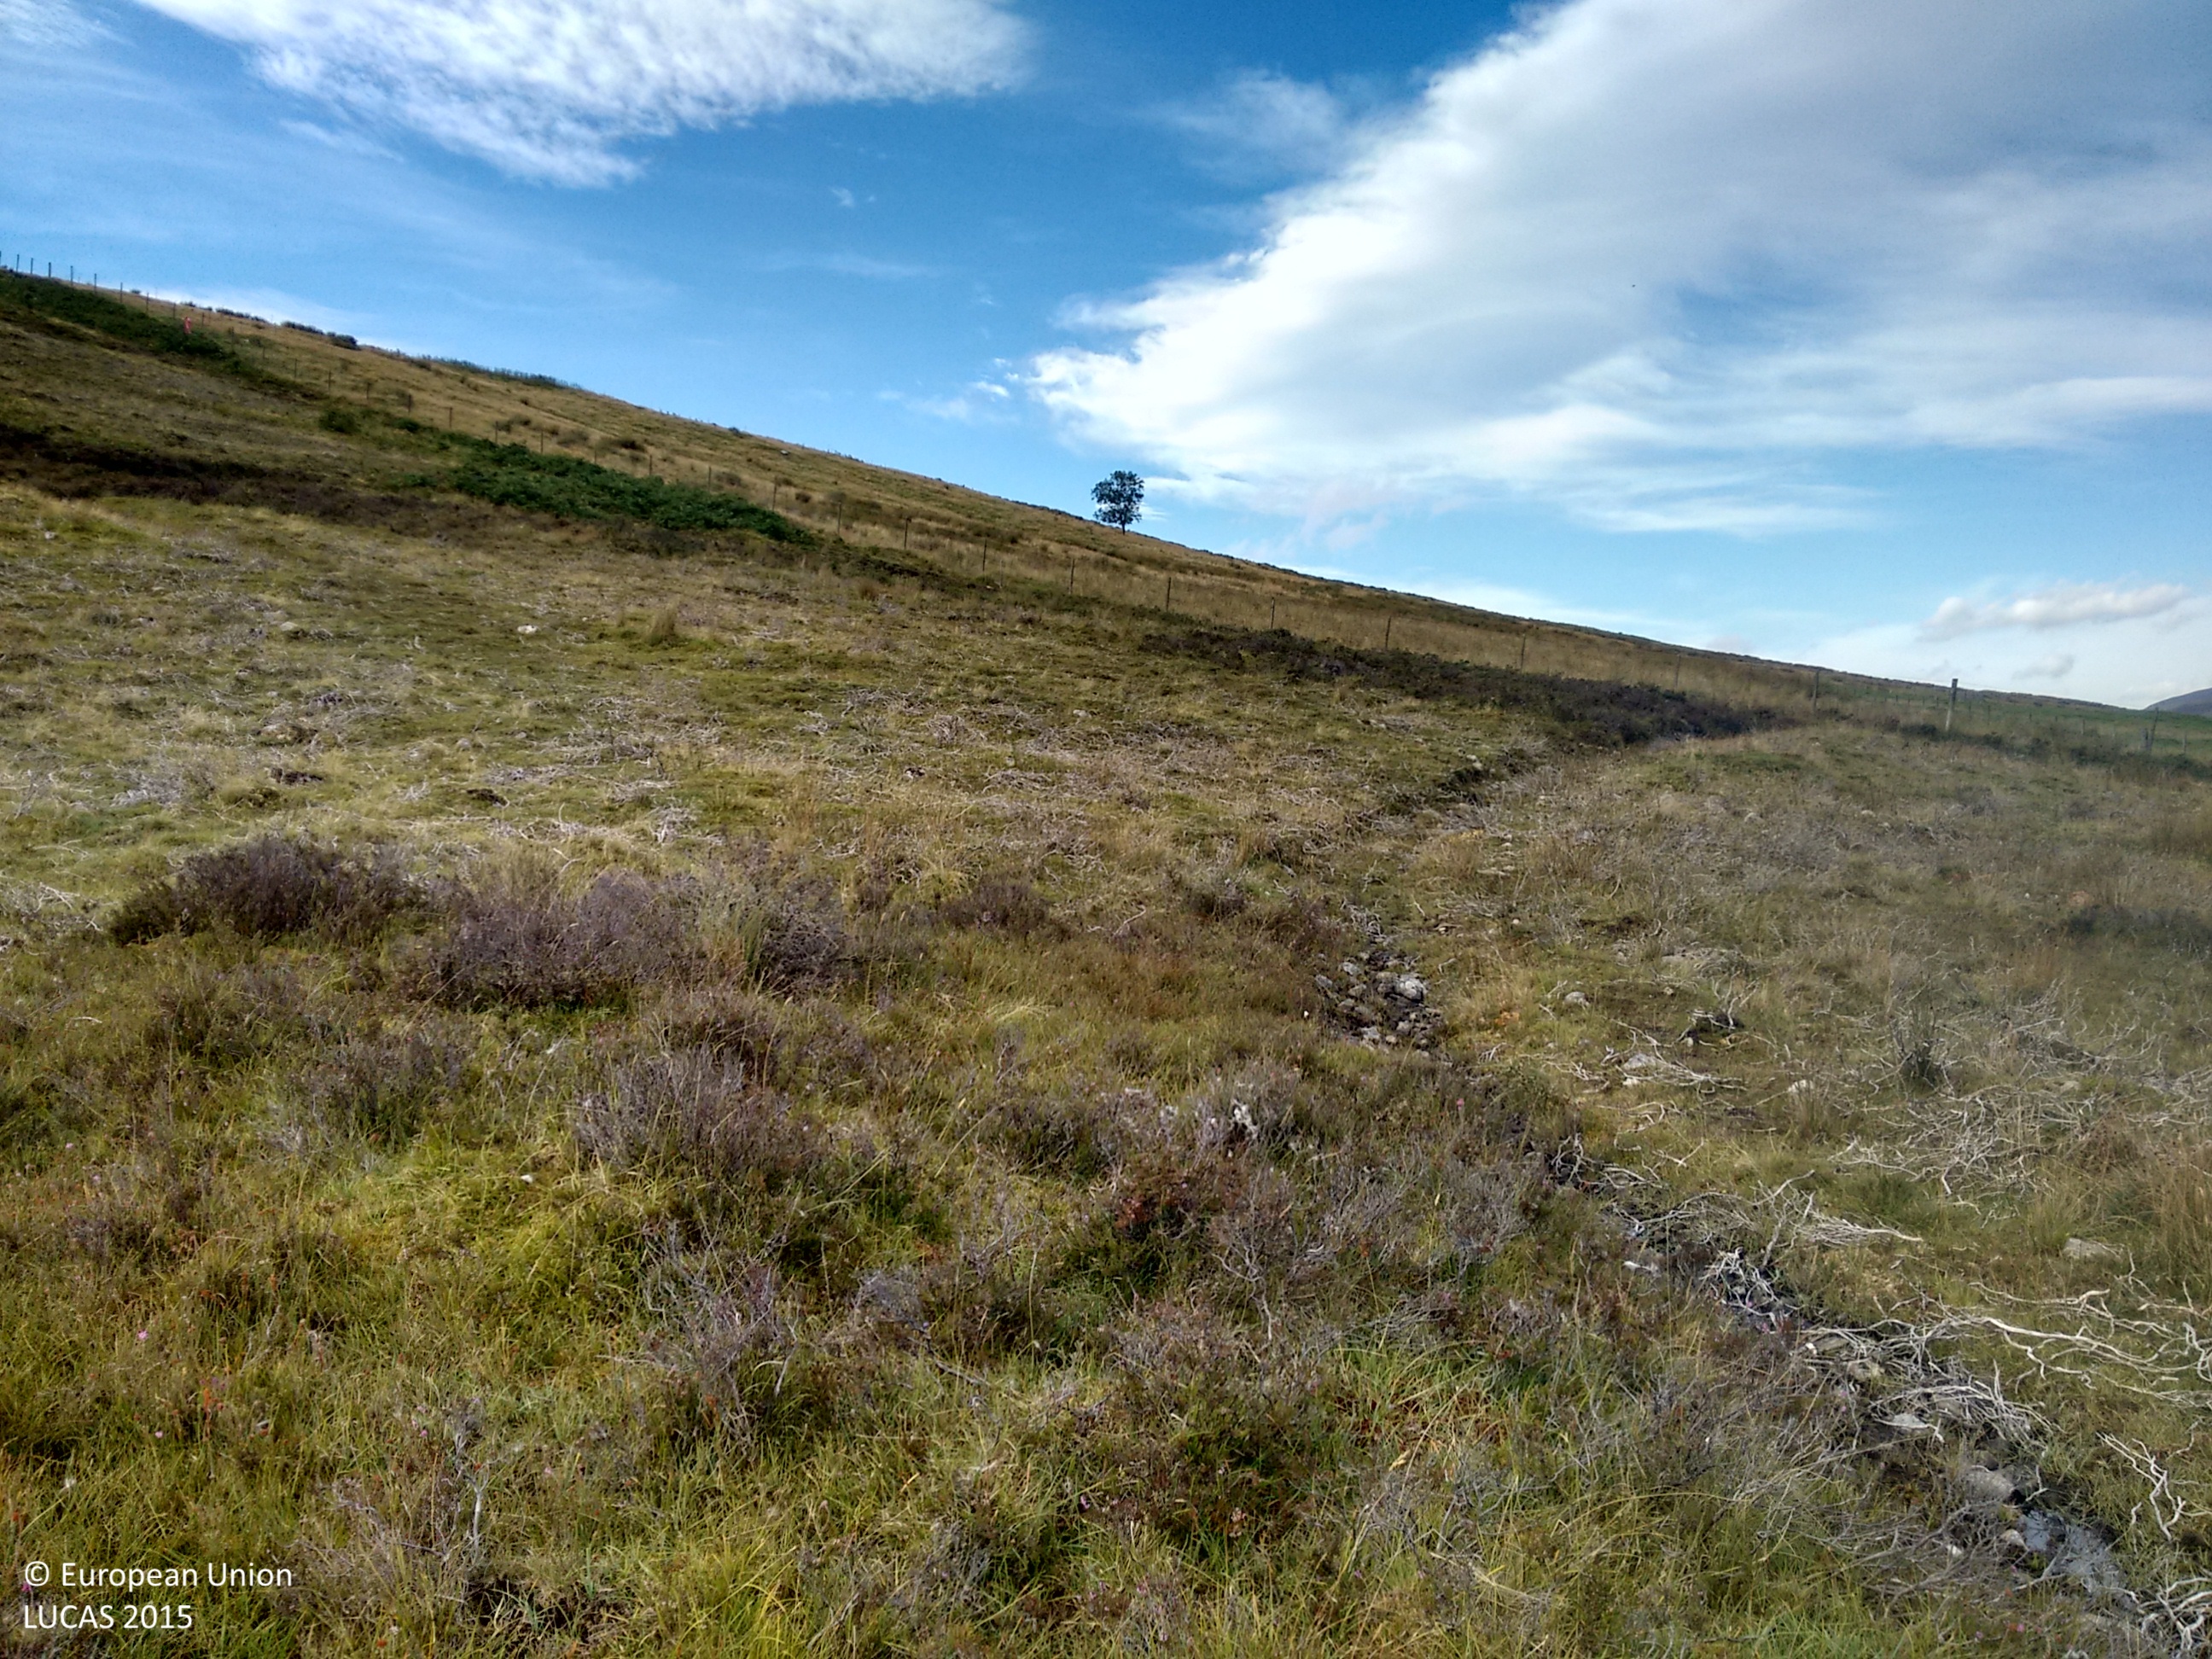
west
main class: Grassland
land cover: Grassland without tree/shrub cover
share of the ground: > 75 %
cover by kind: herbaceous plants 95 %, shrubs 5 %
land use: Agriculture (excluding fallow land and kitchen gardens)
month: September
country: GB
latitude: 57.8879
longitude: -4.4755
